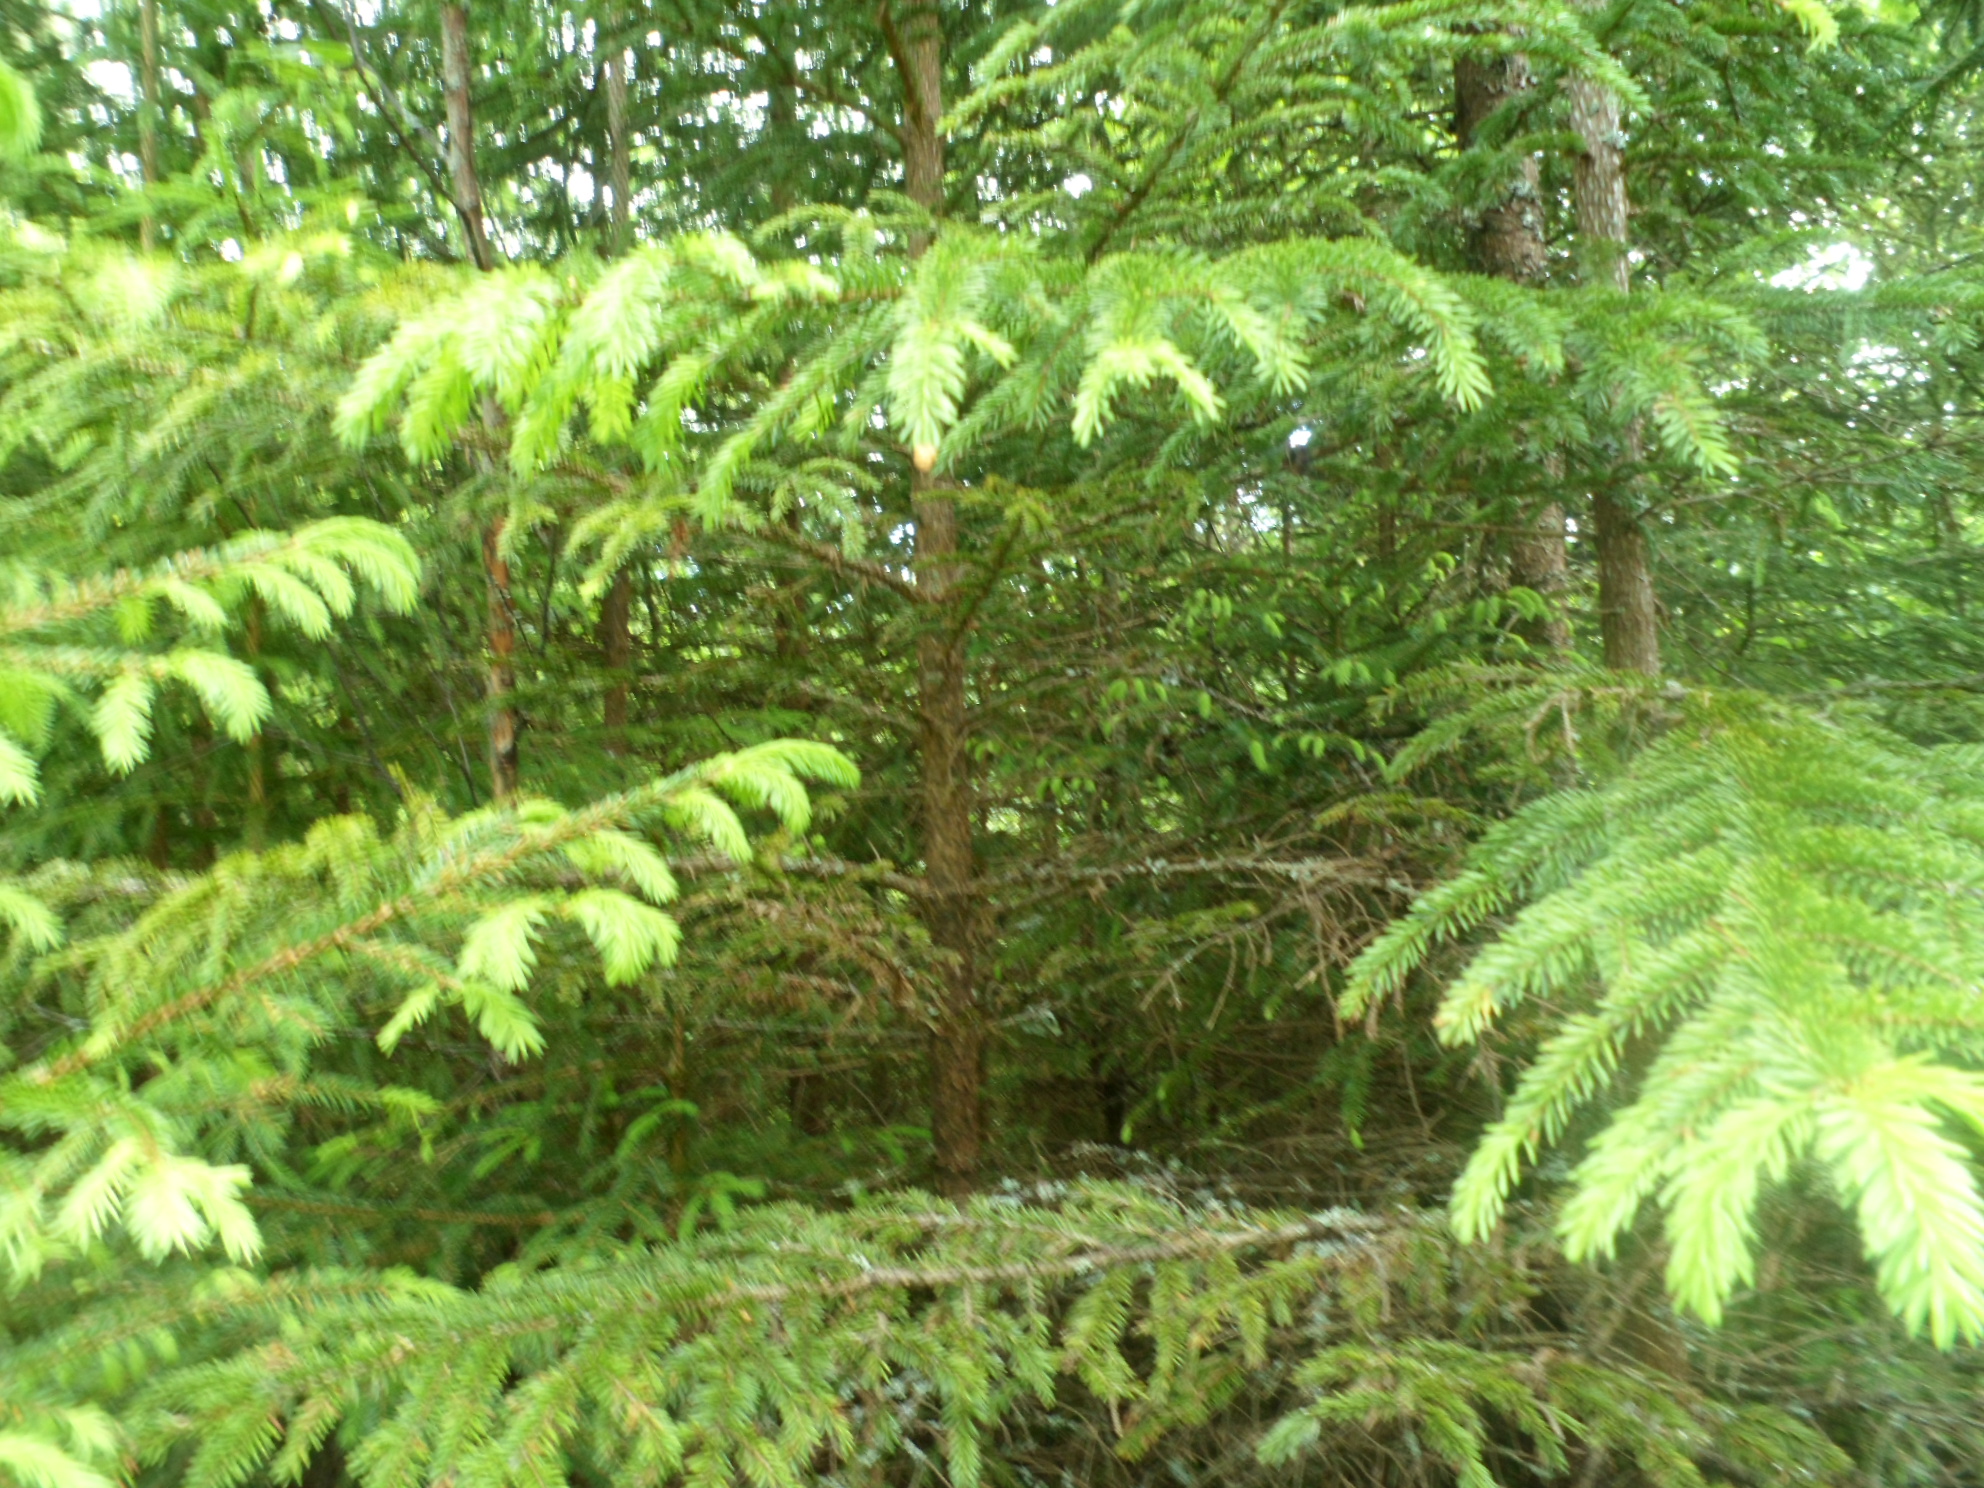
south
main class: Woodland
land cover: Spruce dominated mixed woodland
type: boreal forest
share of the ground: > 75 %
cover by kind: coniferous forest trees 40 %, broadleaved forest trees 40 %, lichens and mosses 10 %, shrubs 5 %, herbaceous plants 5 %
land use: Forestry
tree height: > 5 m
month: June
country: SE
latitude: 57.0194
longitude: 14.1966
